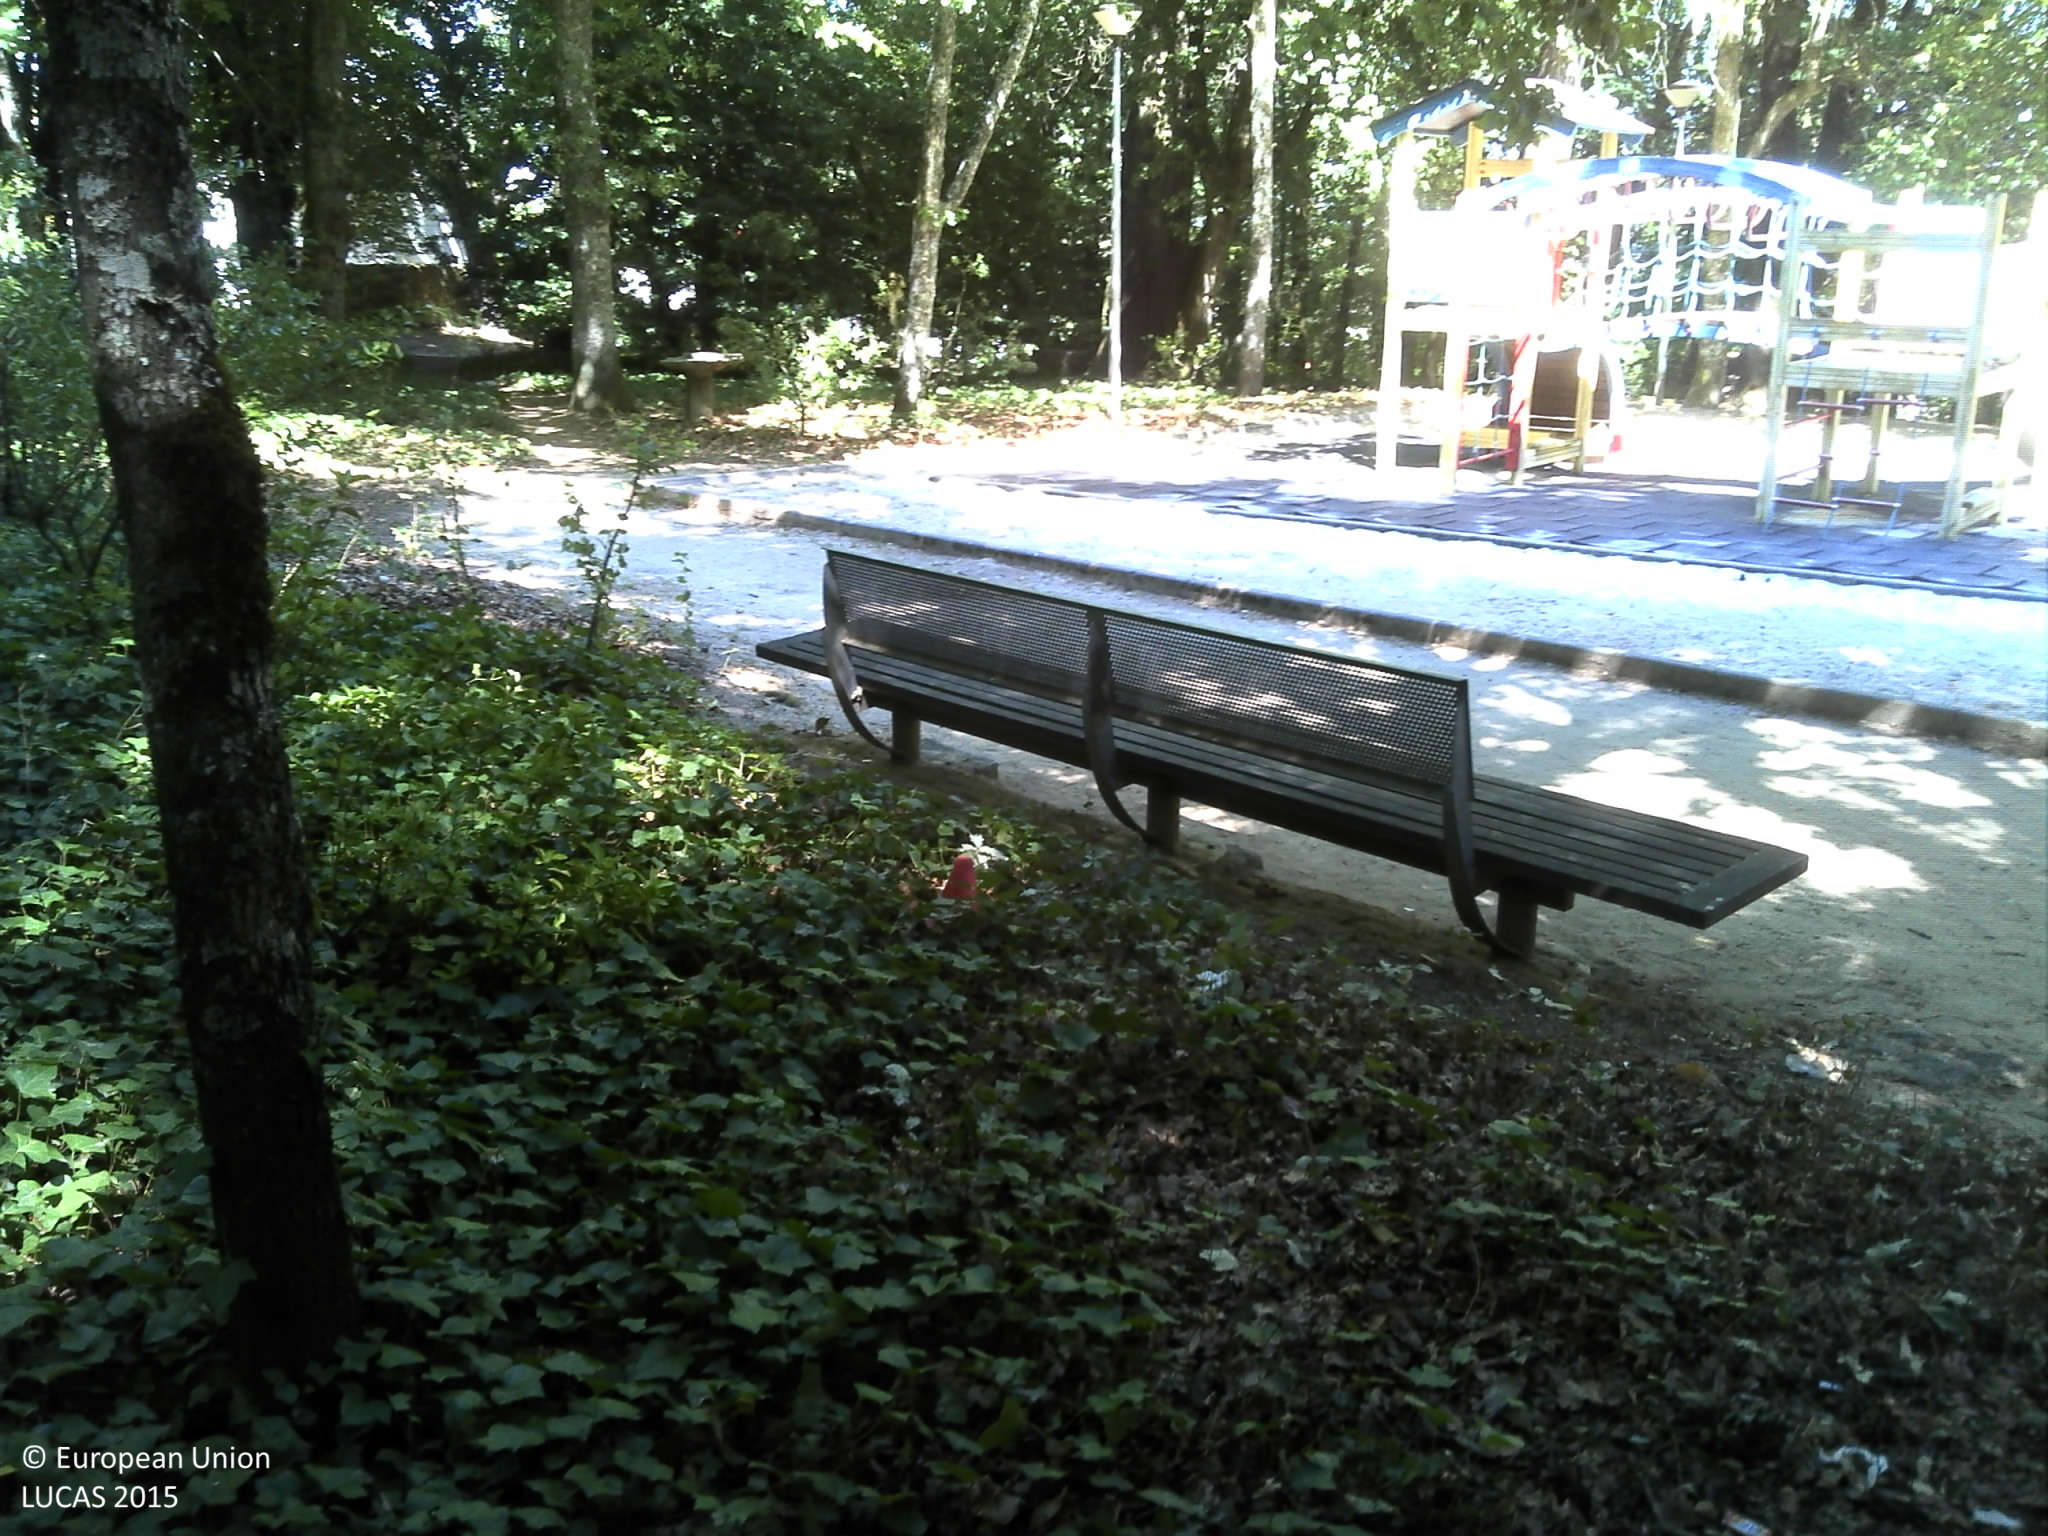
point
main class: Woodland
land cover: Broadleaved woodland
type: thermophilous deciduous forest
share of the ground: 50 - 75 %
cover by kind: broadleaved forest trees 50 %, herbaceous plants 25 %, unconsolidated bare surface 20 %, coniferous forest trees 5 %
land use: Amenities, museums, leisure
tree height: > 5 m
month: June
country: PT
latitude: 40.7742
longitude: -7.3509
